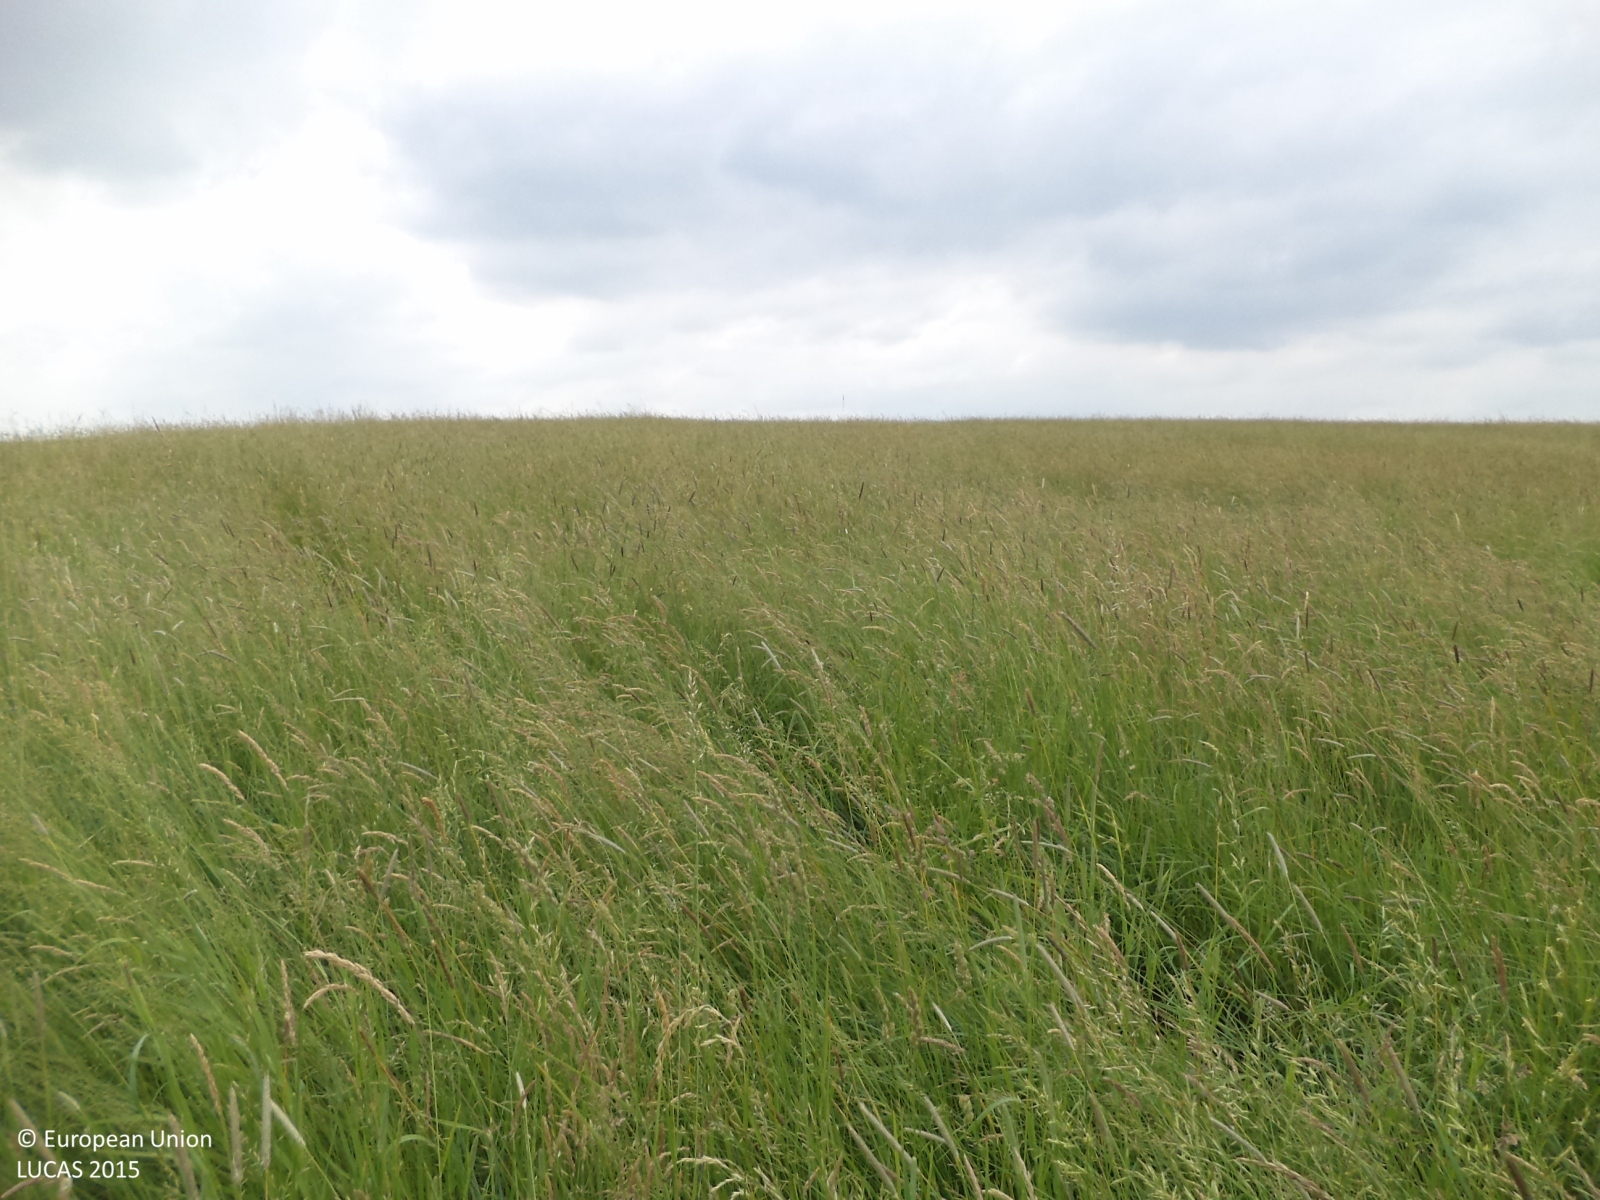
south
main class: Grassland
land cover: Grassland without tree/shrub cover
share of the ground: > 75 %
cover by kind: herbaceous plants 100 %
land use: Agriculture (excluding fallow land and kitchen gardens)
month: June
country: CZ
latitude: 49.1561
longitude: 14.5674
